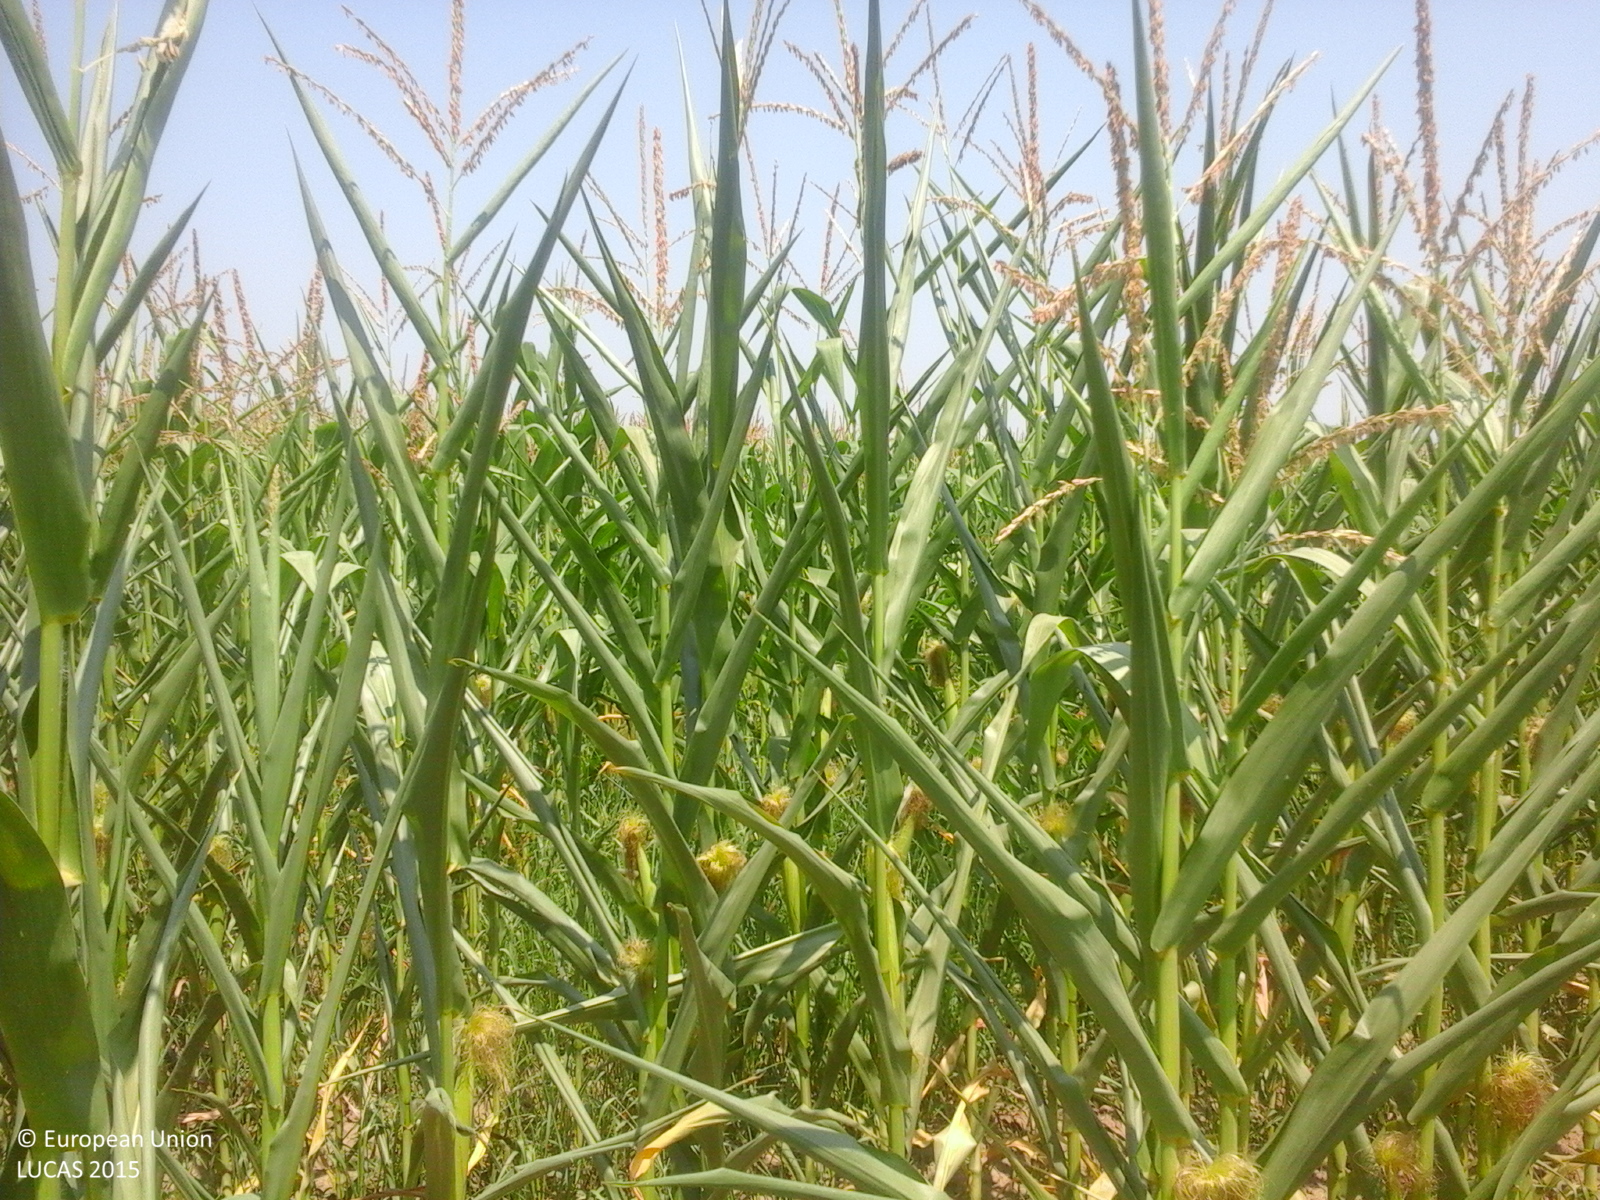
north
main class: Cropland
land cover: Maize
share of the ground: > 75 %
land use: Agriculture (excluding fallow land and kitchen gardens)
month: July
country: RO
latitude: 44.6777
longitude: 25.5226
